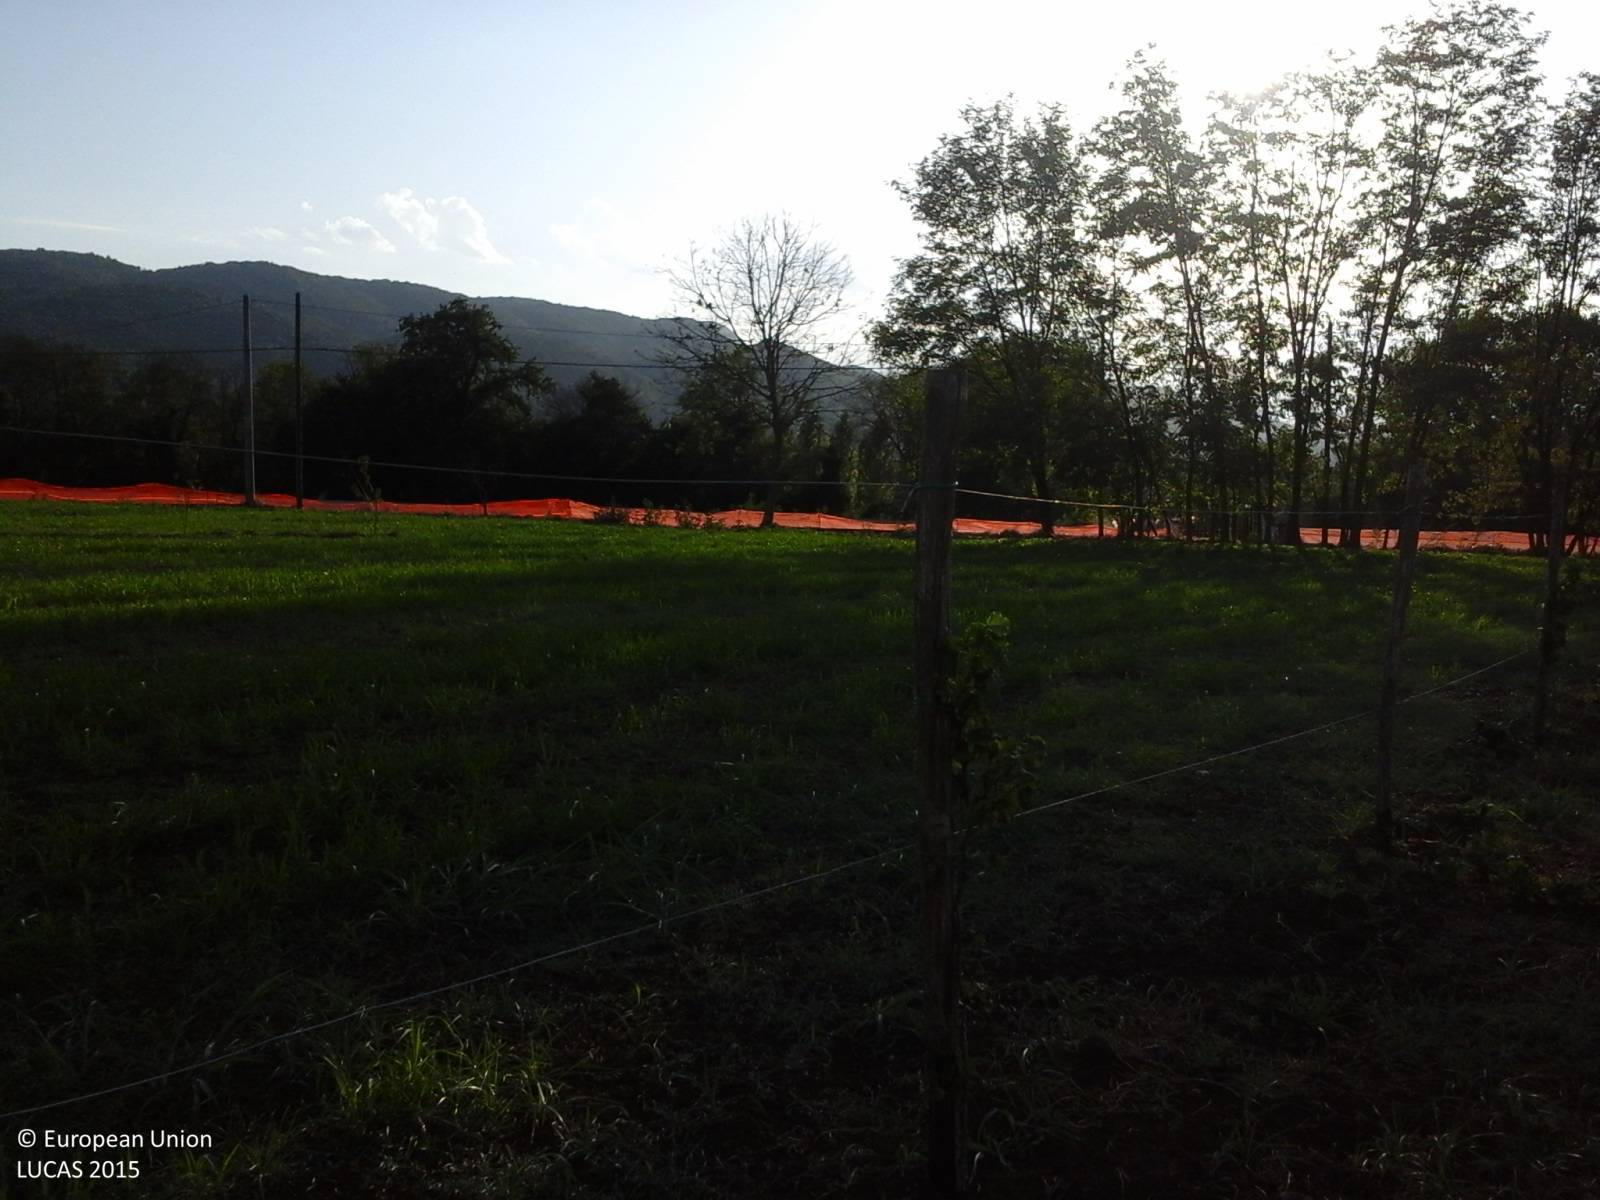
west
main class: Cropland
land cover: Lucerne
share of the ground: > 75 %
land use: Agriculture (excluding fallow land and kitchen gardens)
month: July
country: IT
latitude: 41.2582
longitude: 14.3398
